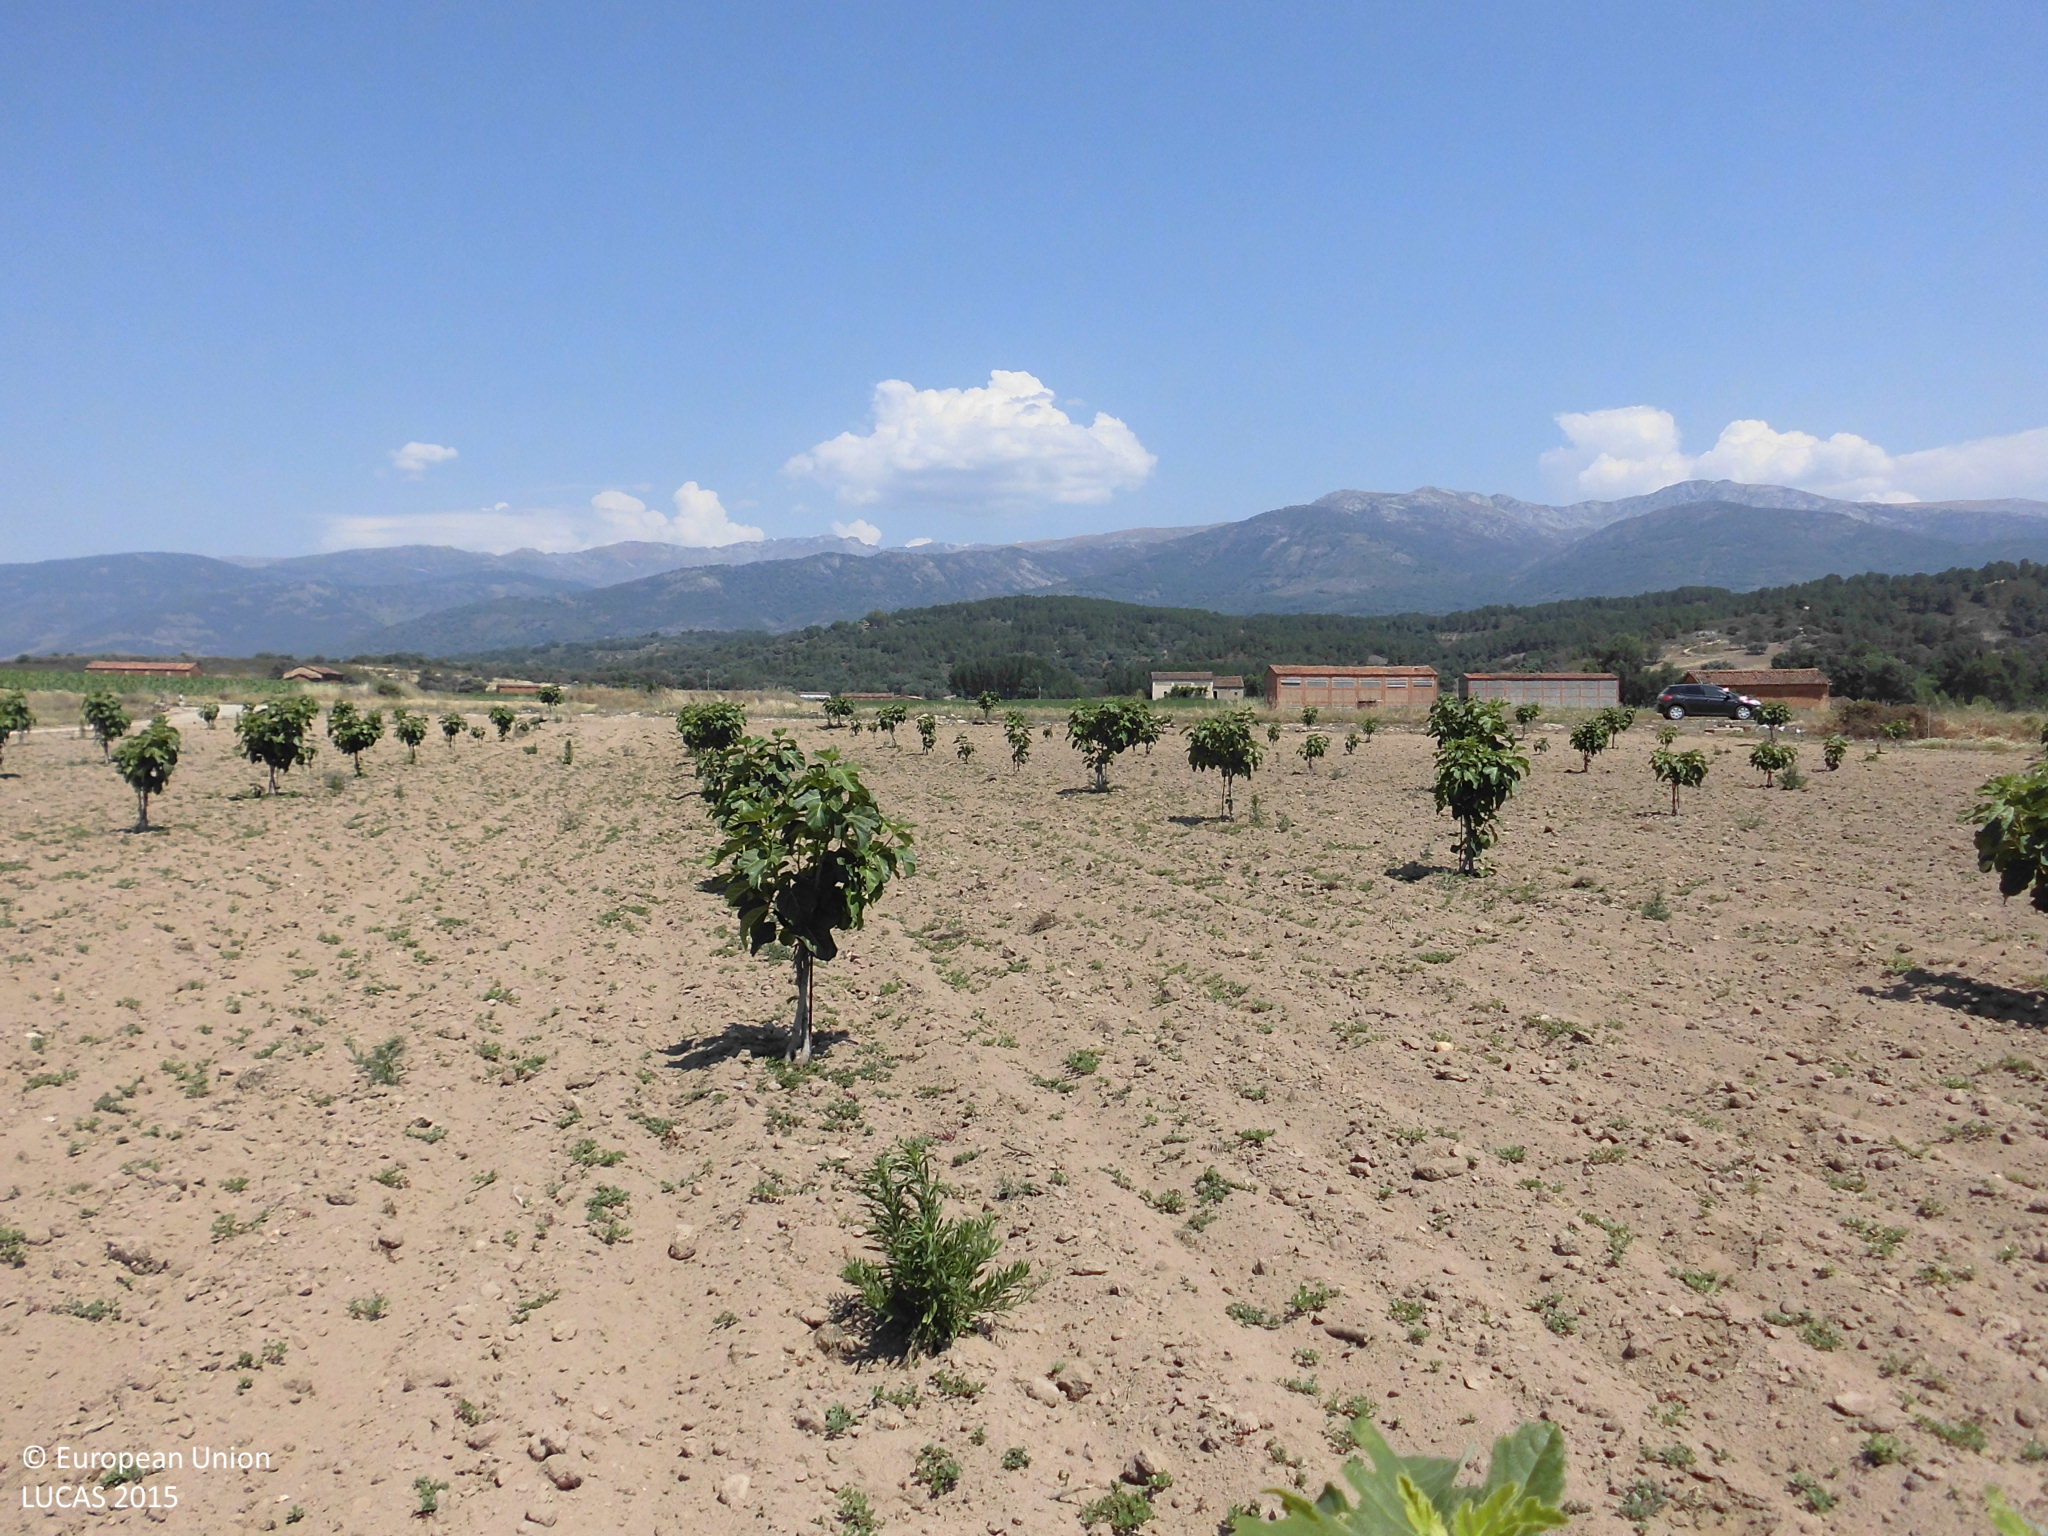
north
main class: Cropland
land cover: Other fruit trees and berries
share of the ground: < 10 %
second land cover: Other bare soil
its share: > 75 %
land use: Agriculture (excluding fallow land and kitchen gardens)
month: June
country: ES
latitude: 40.0742
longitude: -5.5041
